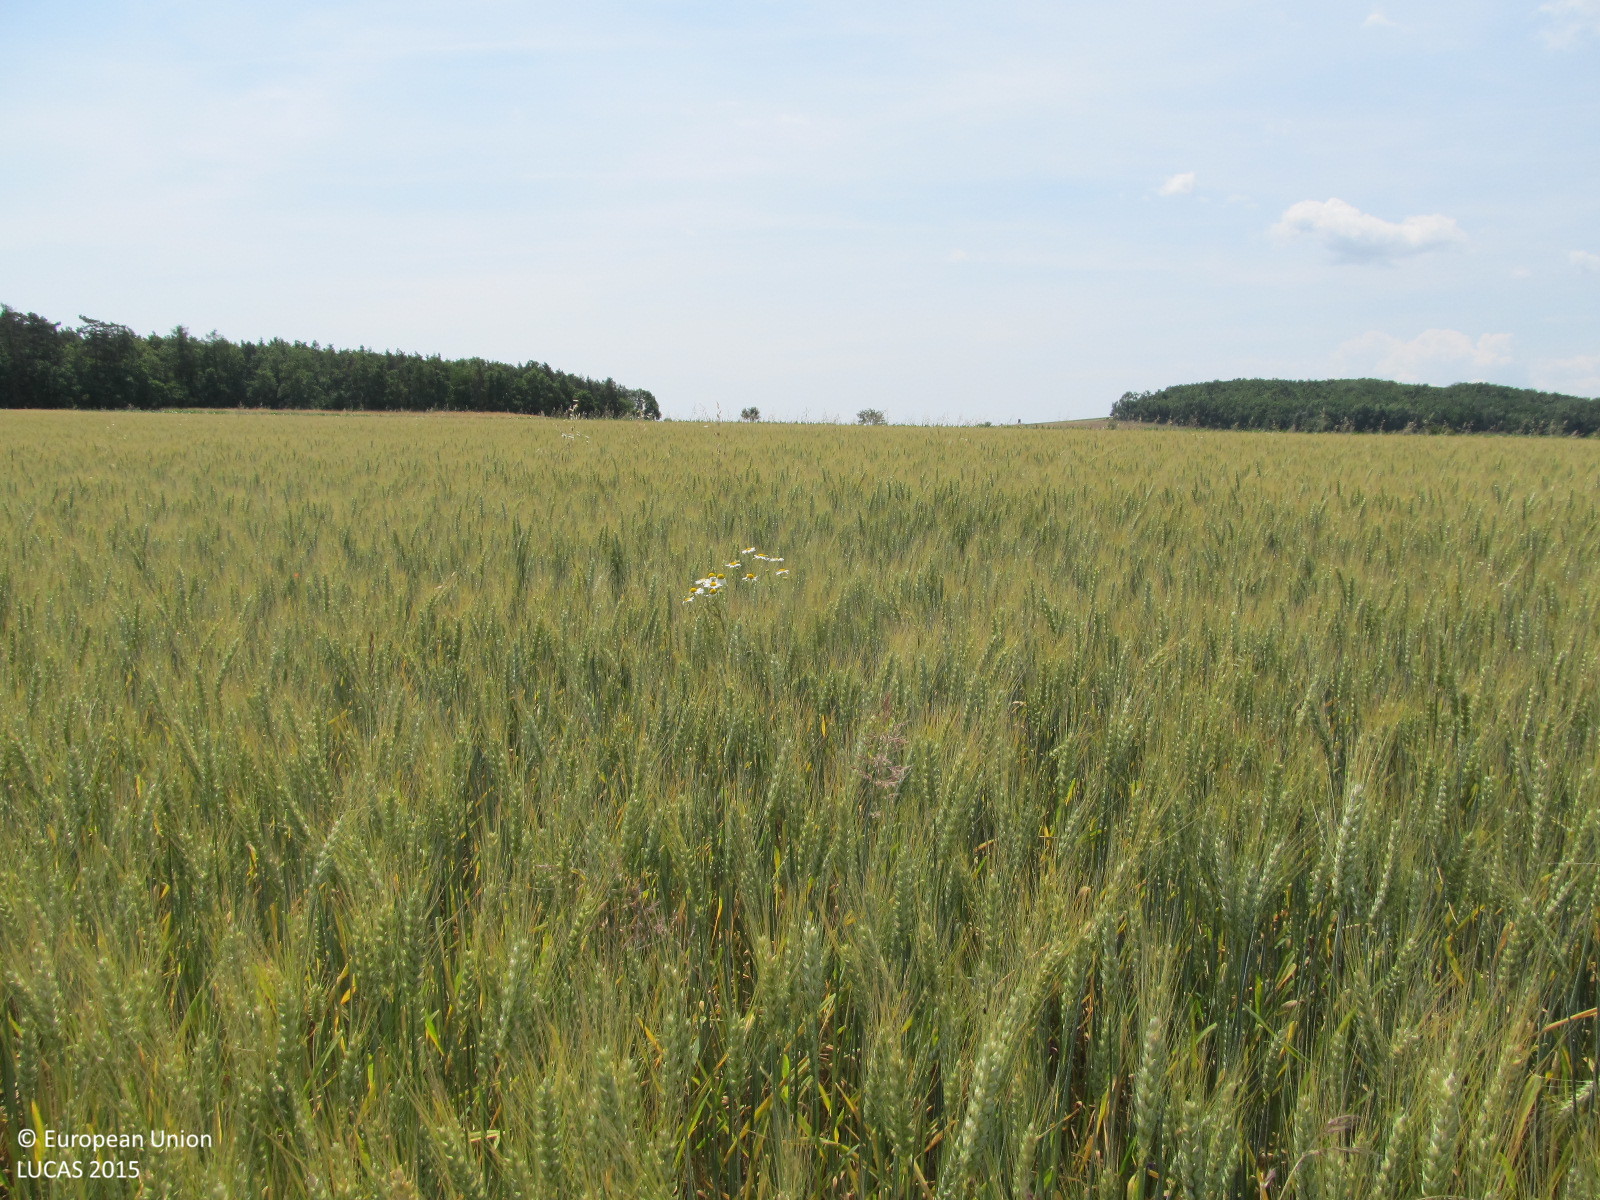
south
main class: Cropland
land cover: Common wheat
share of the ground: > 75 %
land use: Agriculture (excluding fallow land and kitchen gardens)
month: June
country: AT
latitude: 48.6288
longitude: 15.8246
